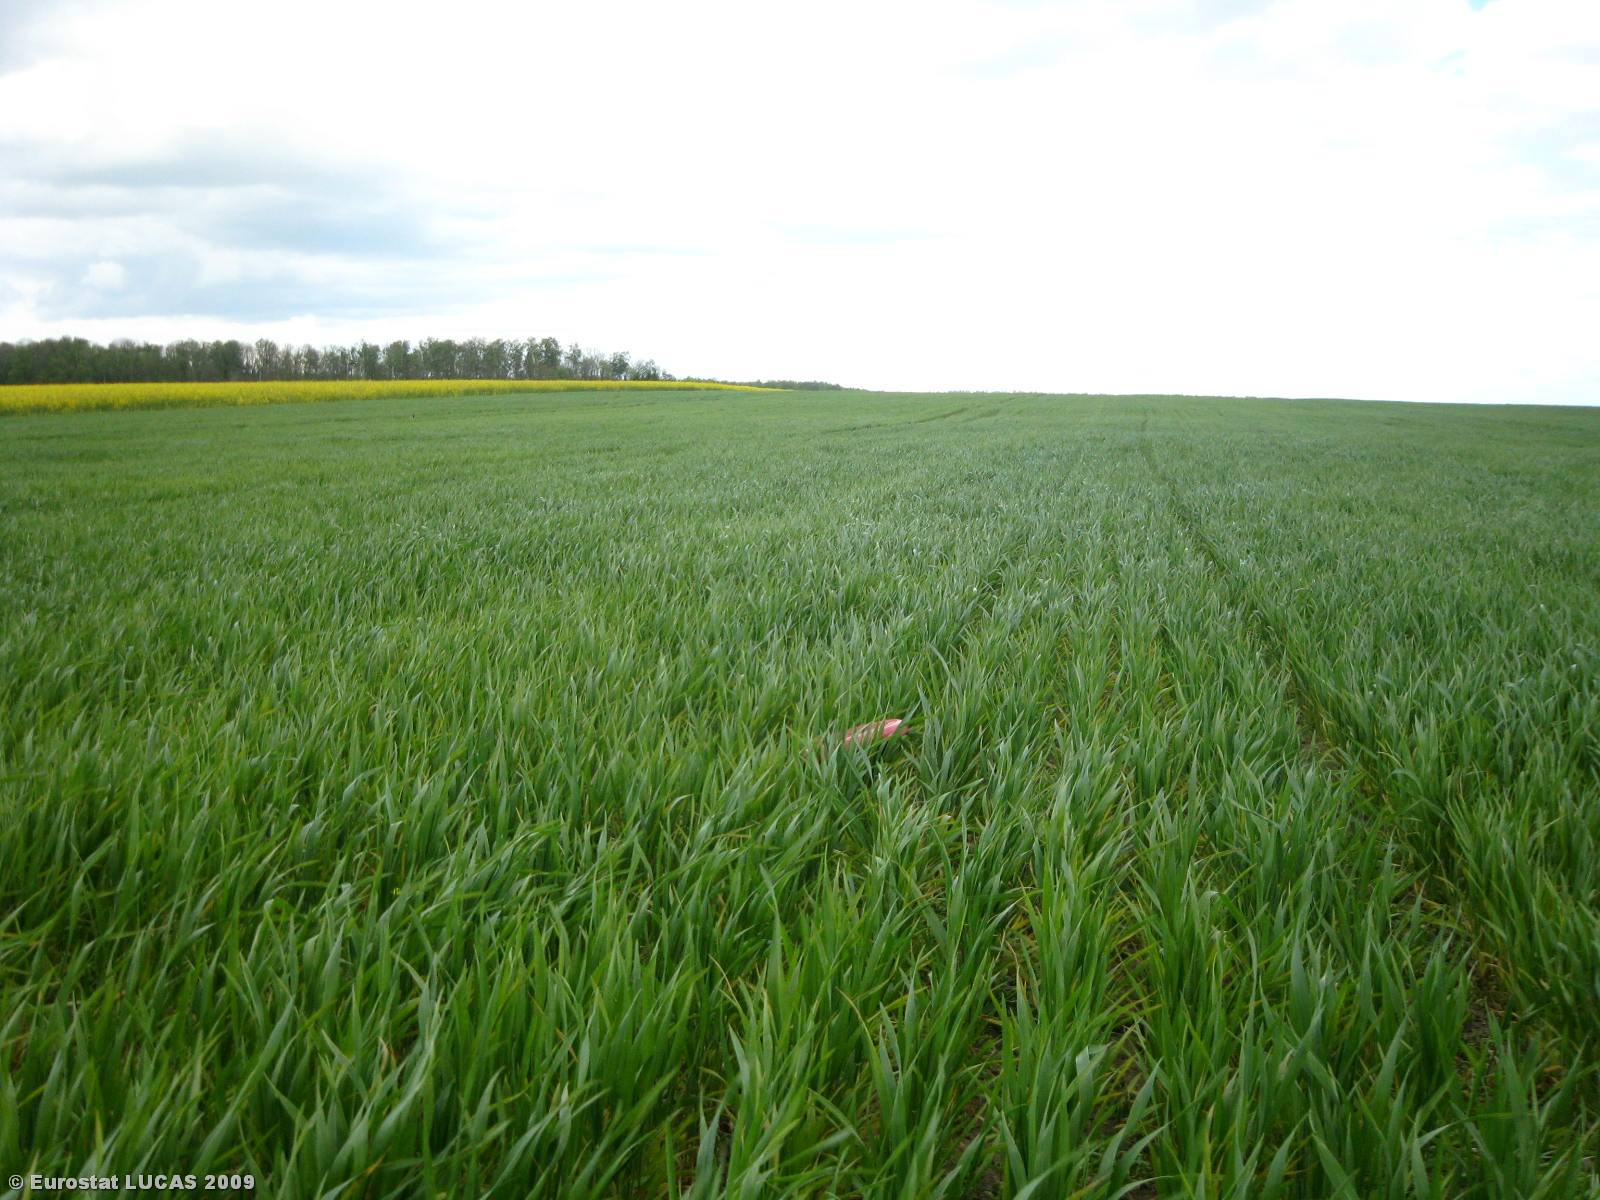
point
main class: Cropland
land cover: Common wheat
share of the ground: > 75 %
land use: Agriculture (excluding fallow land and kitchen gardens)
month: May
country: LT
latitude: 56.0117
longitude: 24.0590
